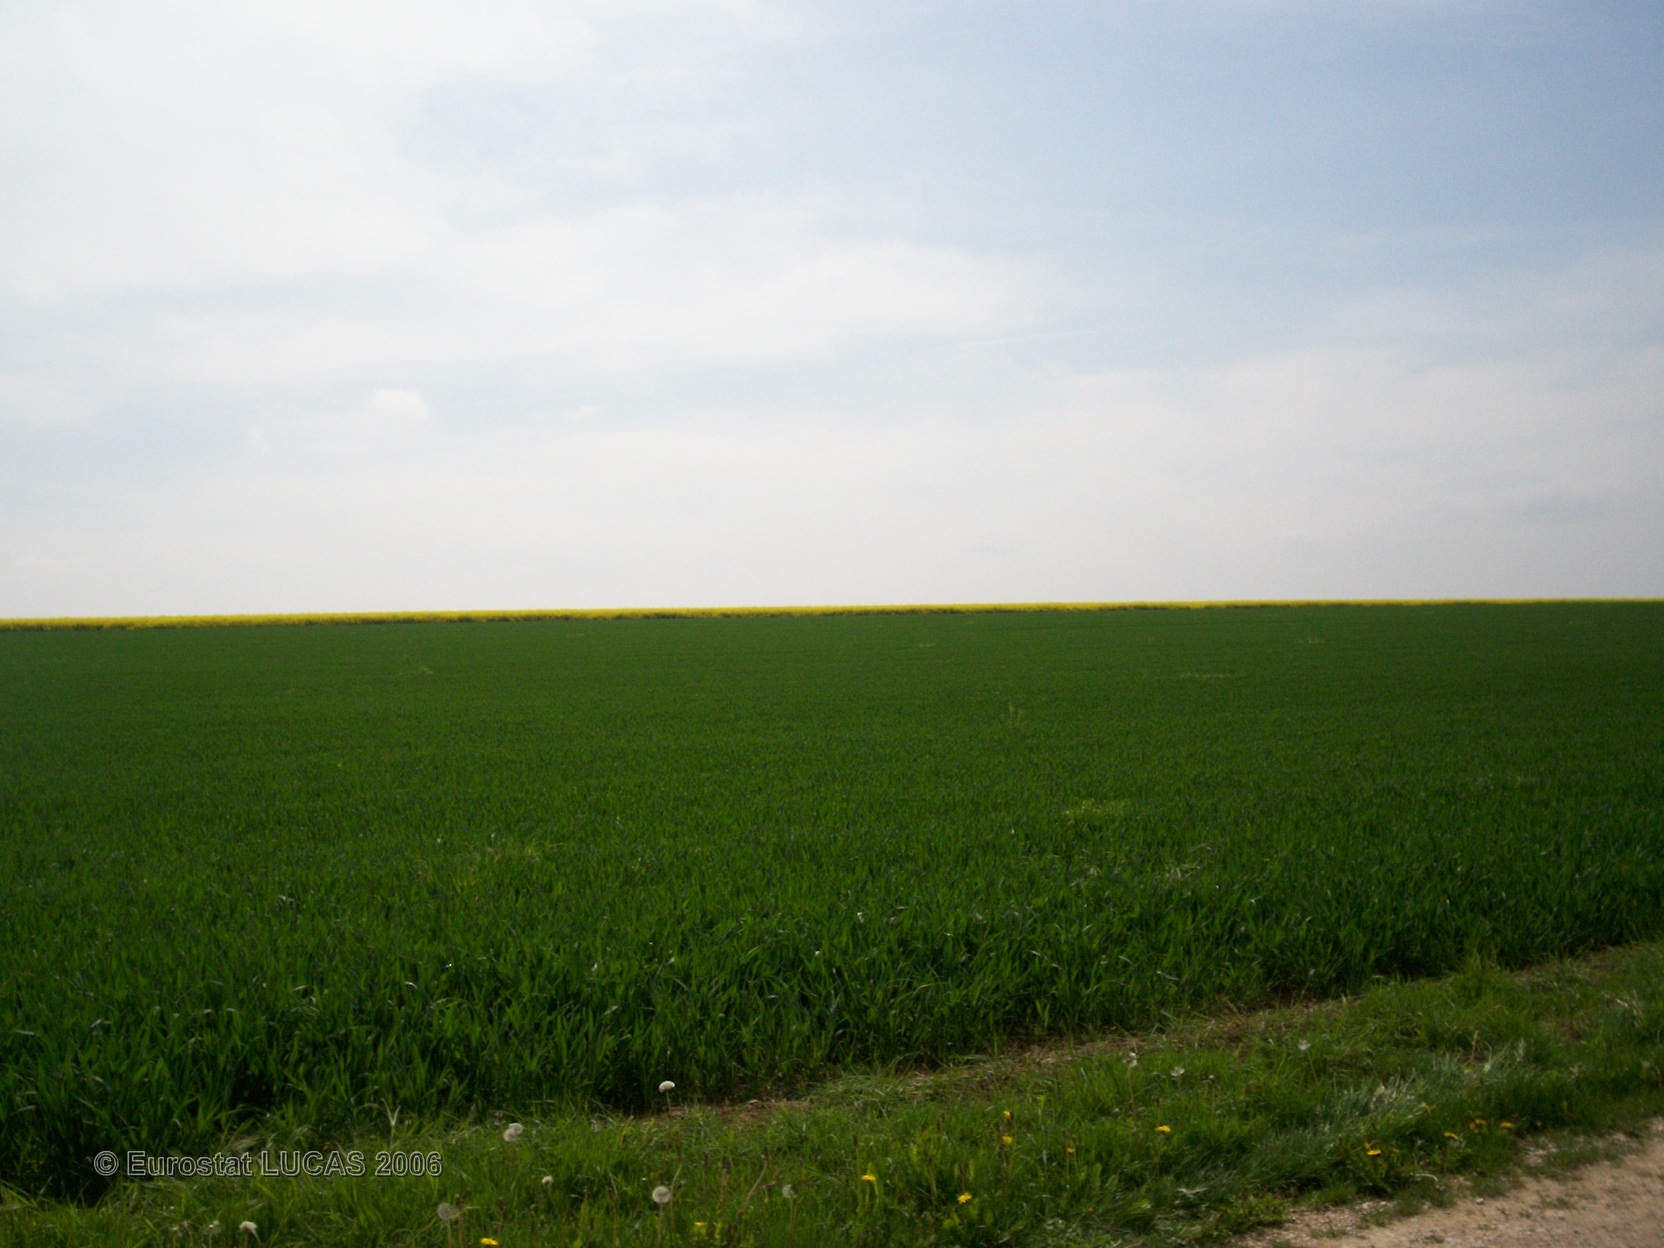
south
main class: Cropland
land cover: Rape and turnip rape
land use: Agriculture (excluding fallow land and kitchen gardens)
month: May
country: FR
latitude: 49.0040
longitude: 4.4602
